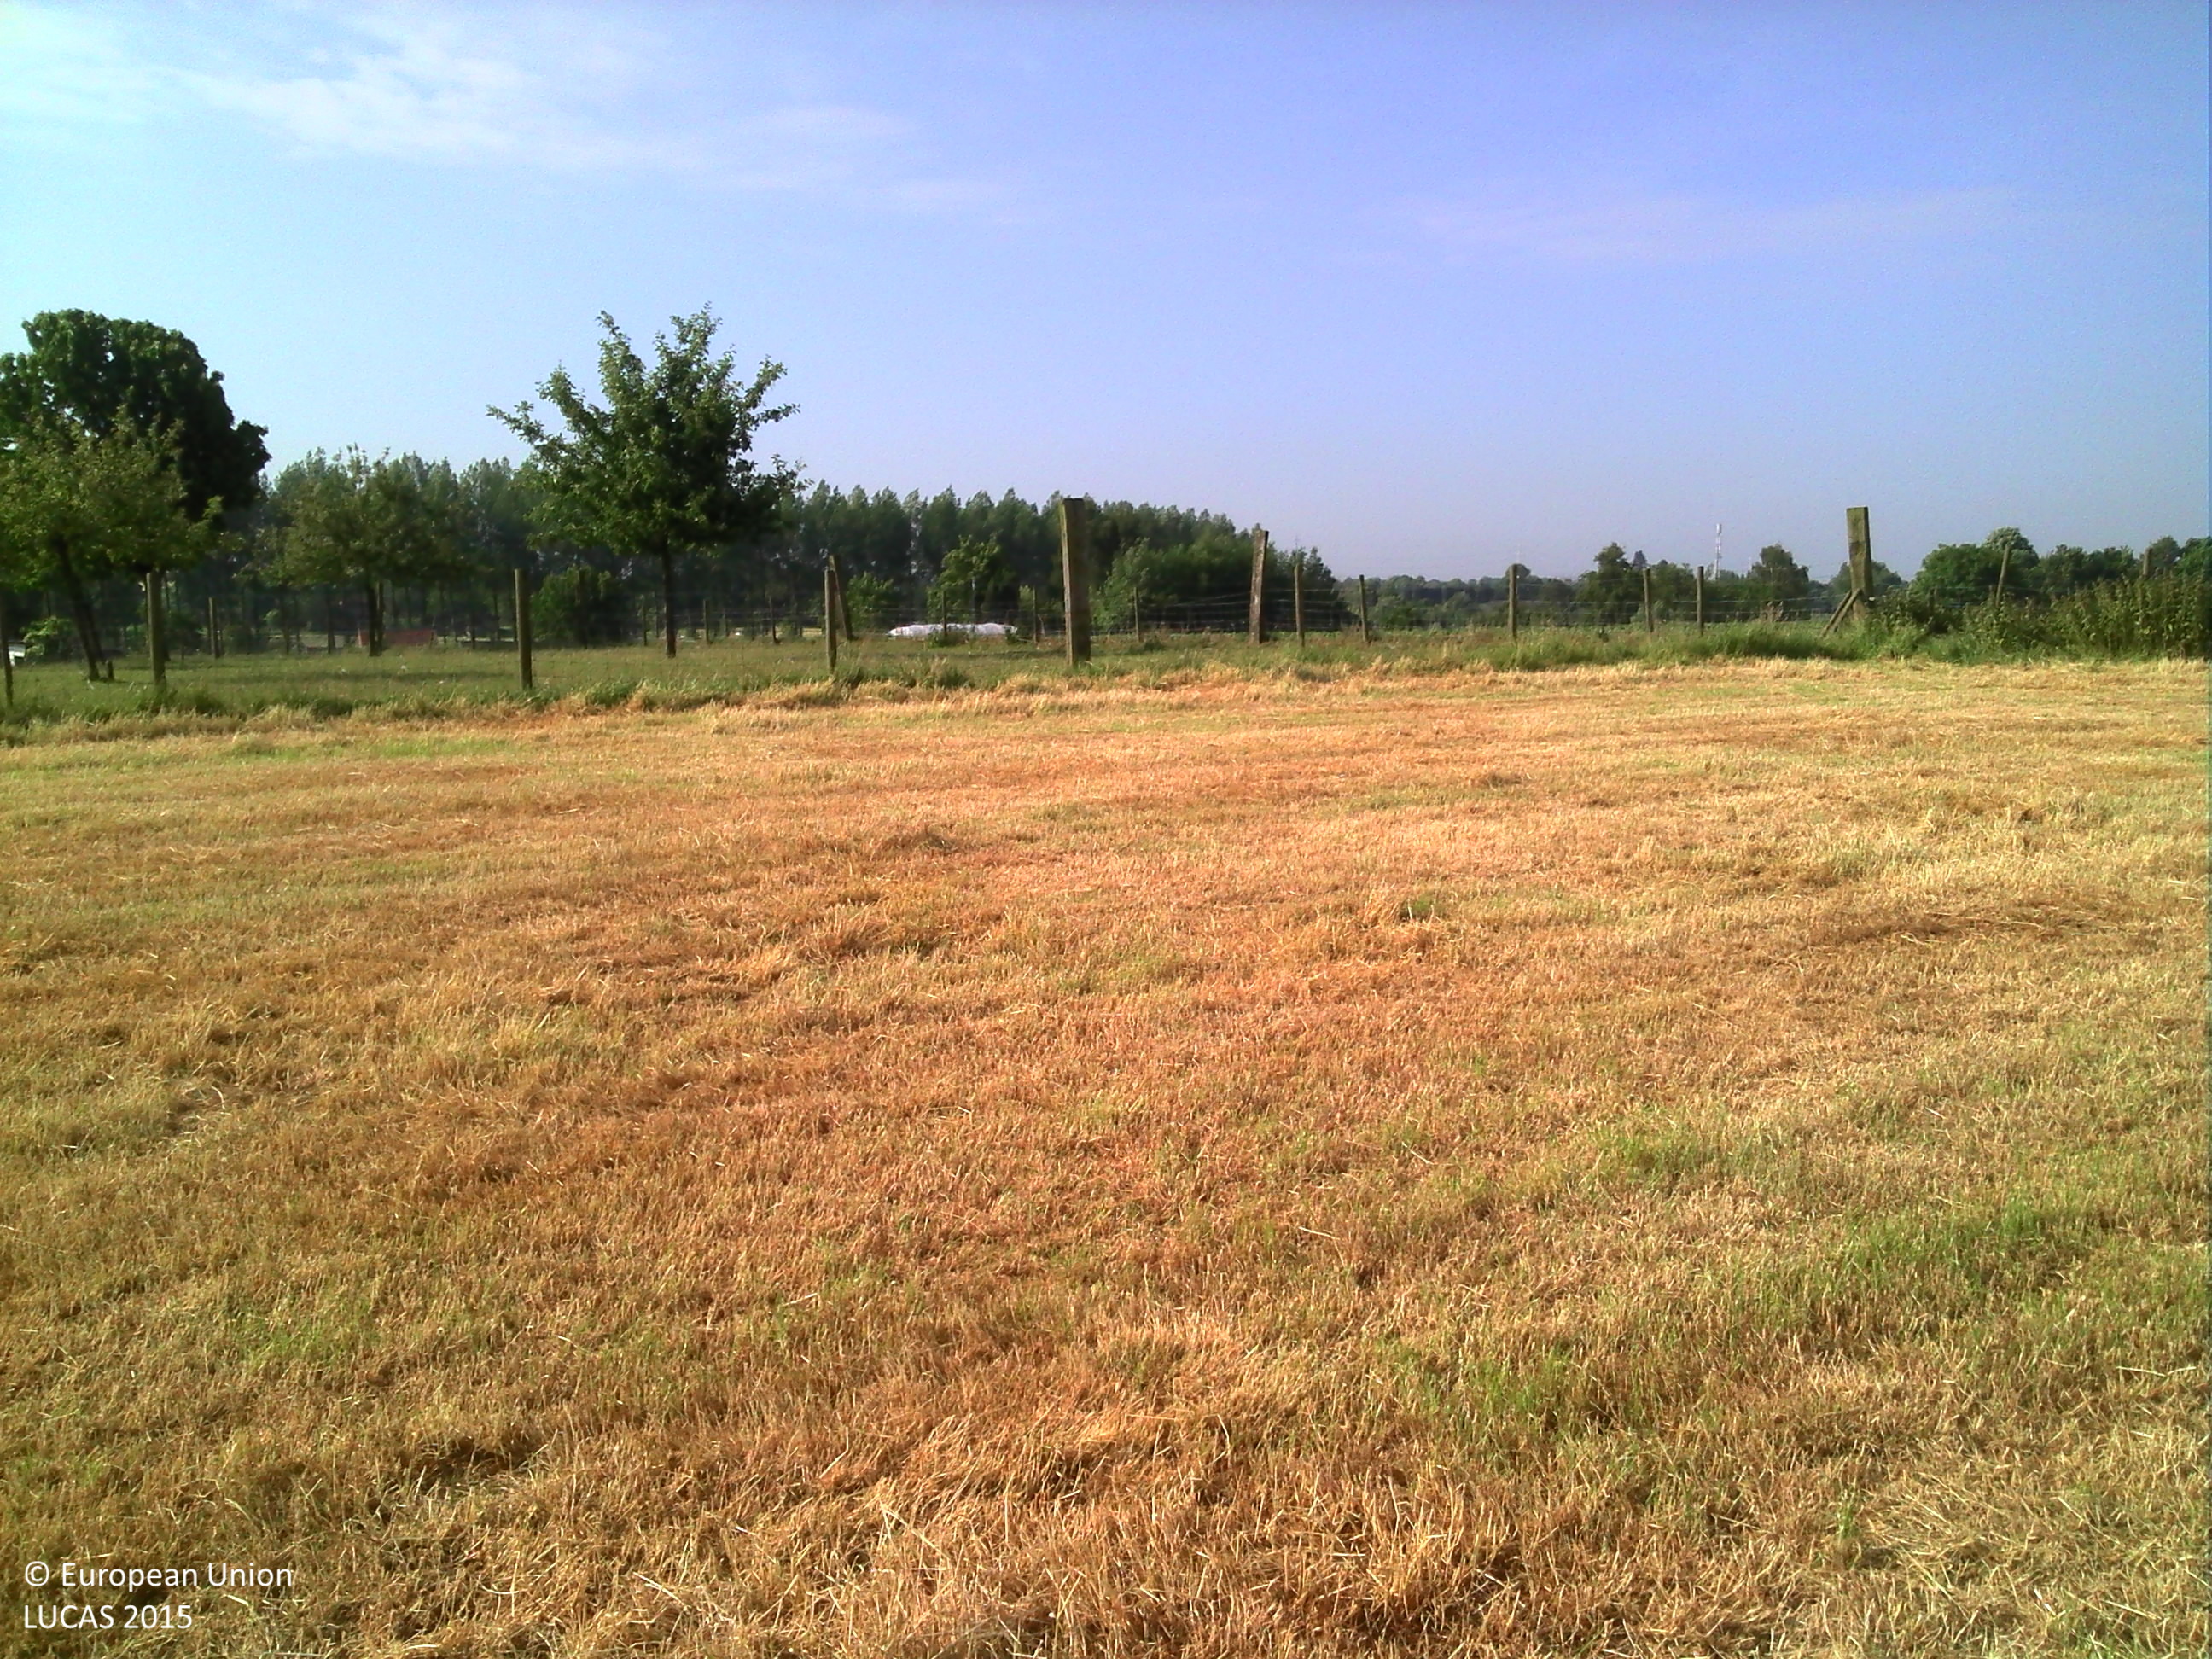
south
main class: Grassland
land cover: Grassland without tree/shrub cover
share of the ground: > 75 %
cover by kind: herbaceous plants 100 %
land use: Agriculture (excluding fallow land and kitchen gardens)
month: June
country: BE
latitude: 50.7619
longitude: 5.5040
